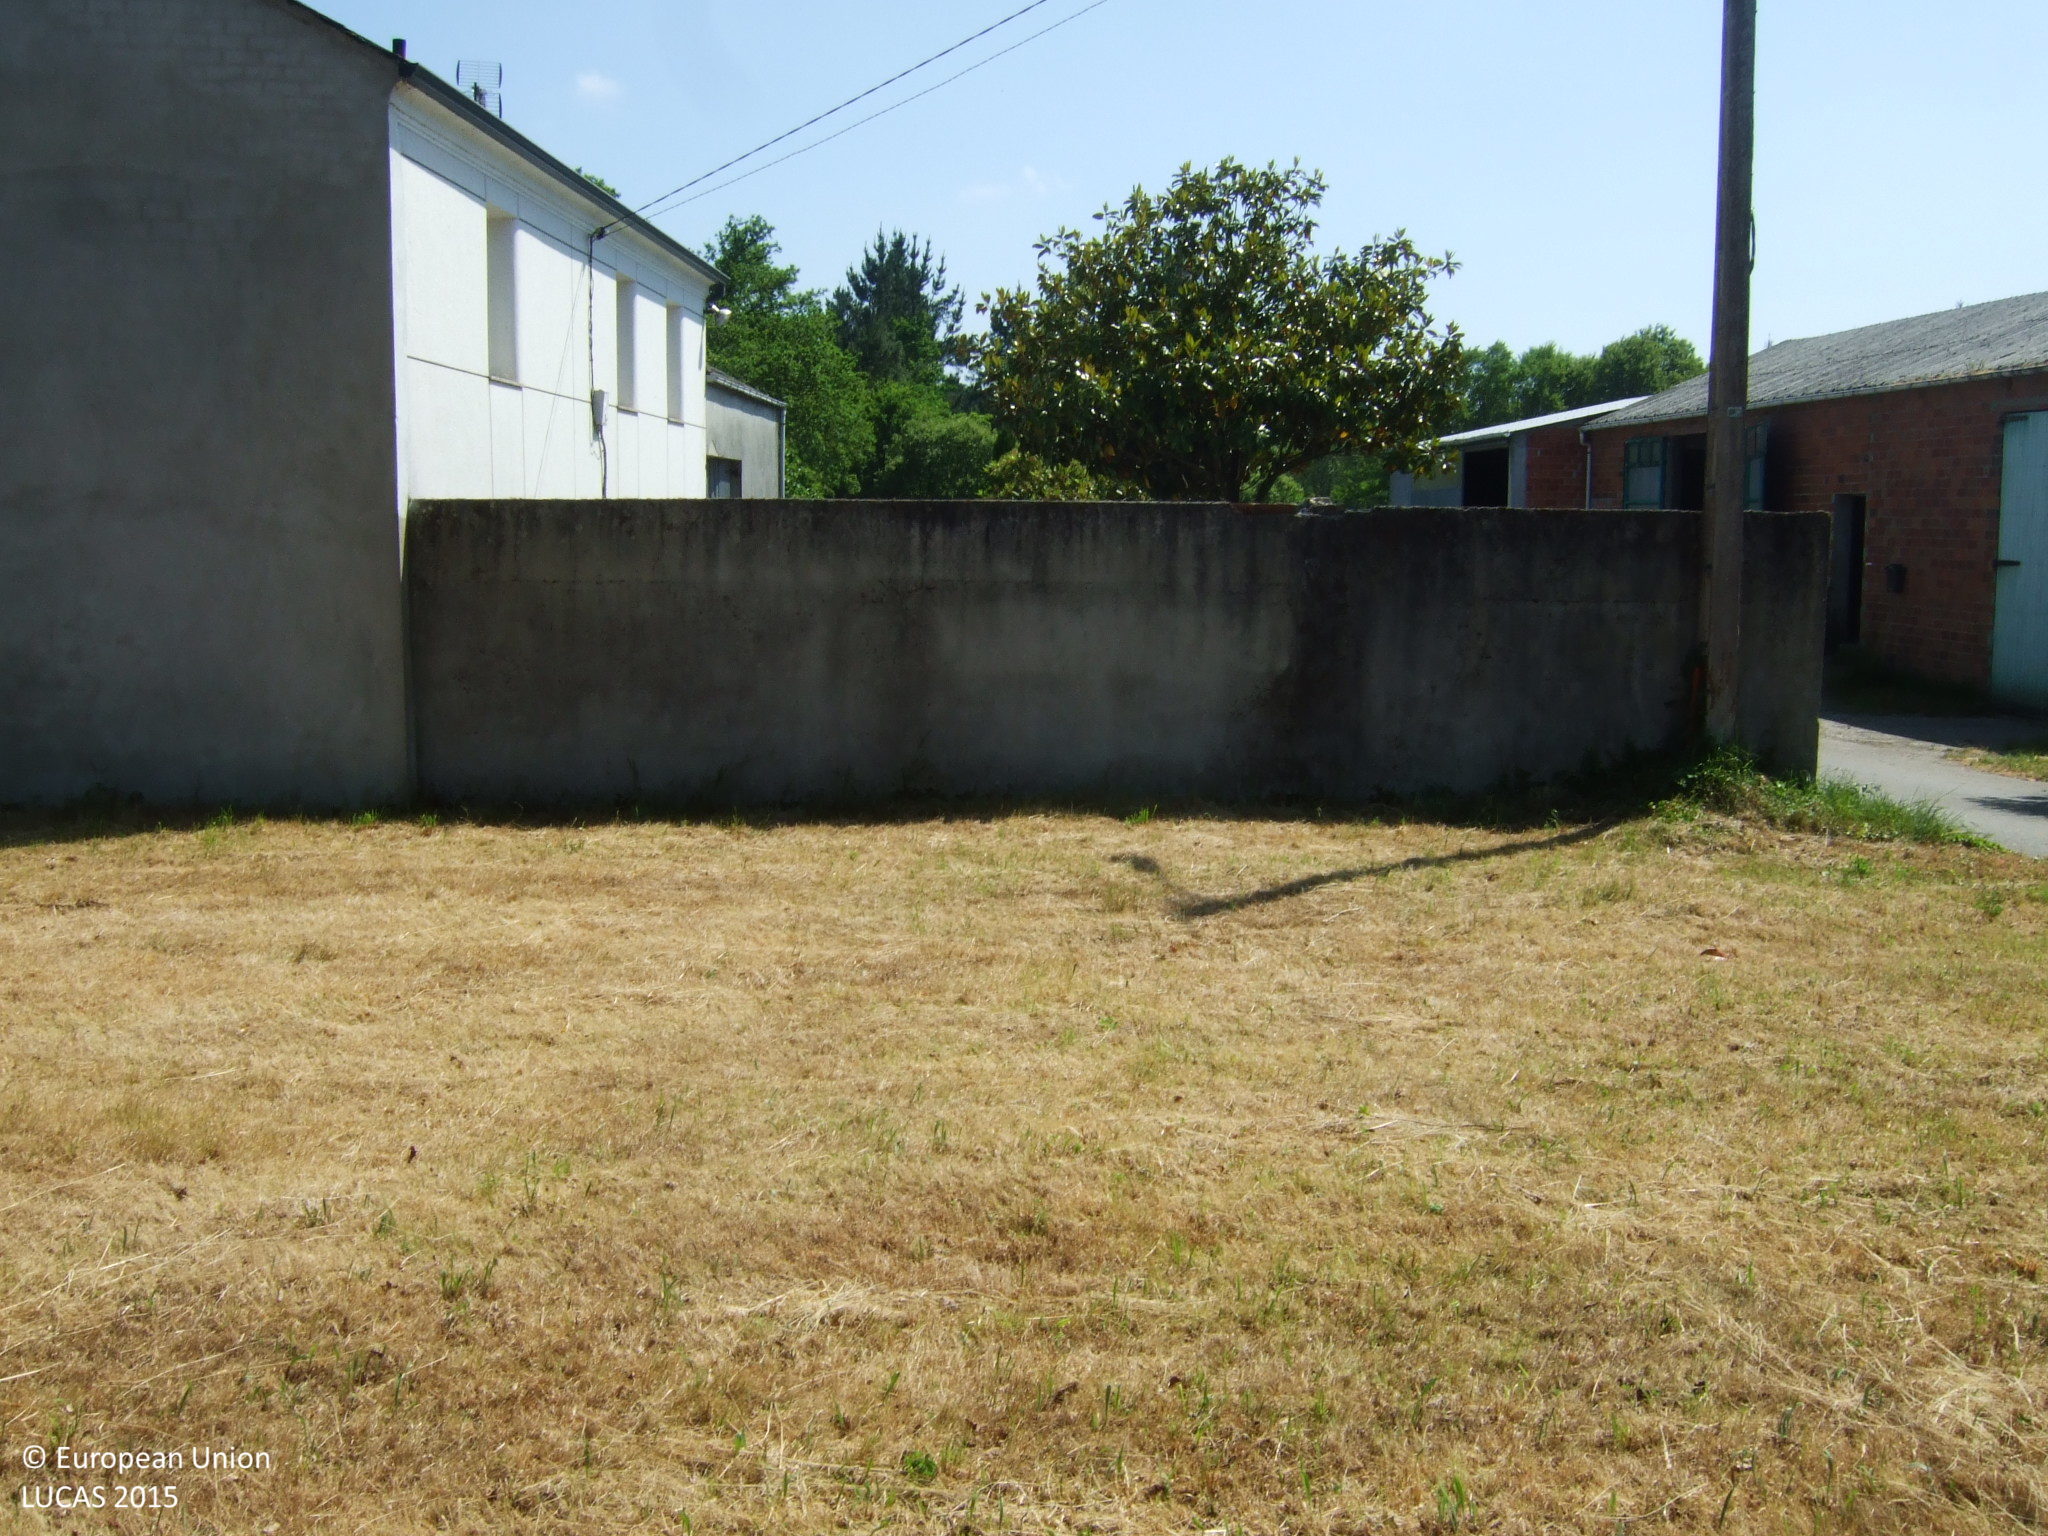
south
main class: Grassland
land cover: Grassland without tree/shrub cover
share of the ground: > 75 %
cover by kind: herbaceous plants 100 %
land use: Agriculture (excluding fallow land and kitchen gardens)
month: June
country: ES
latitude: 43.2790
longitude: -7.4652
